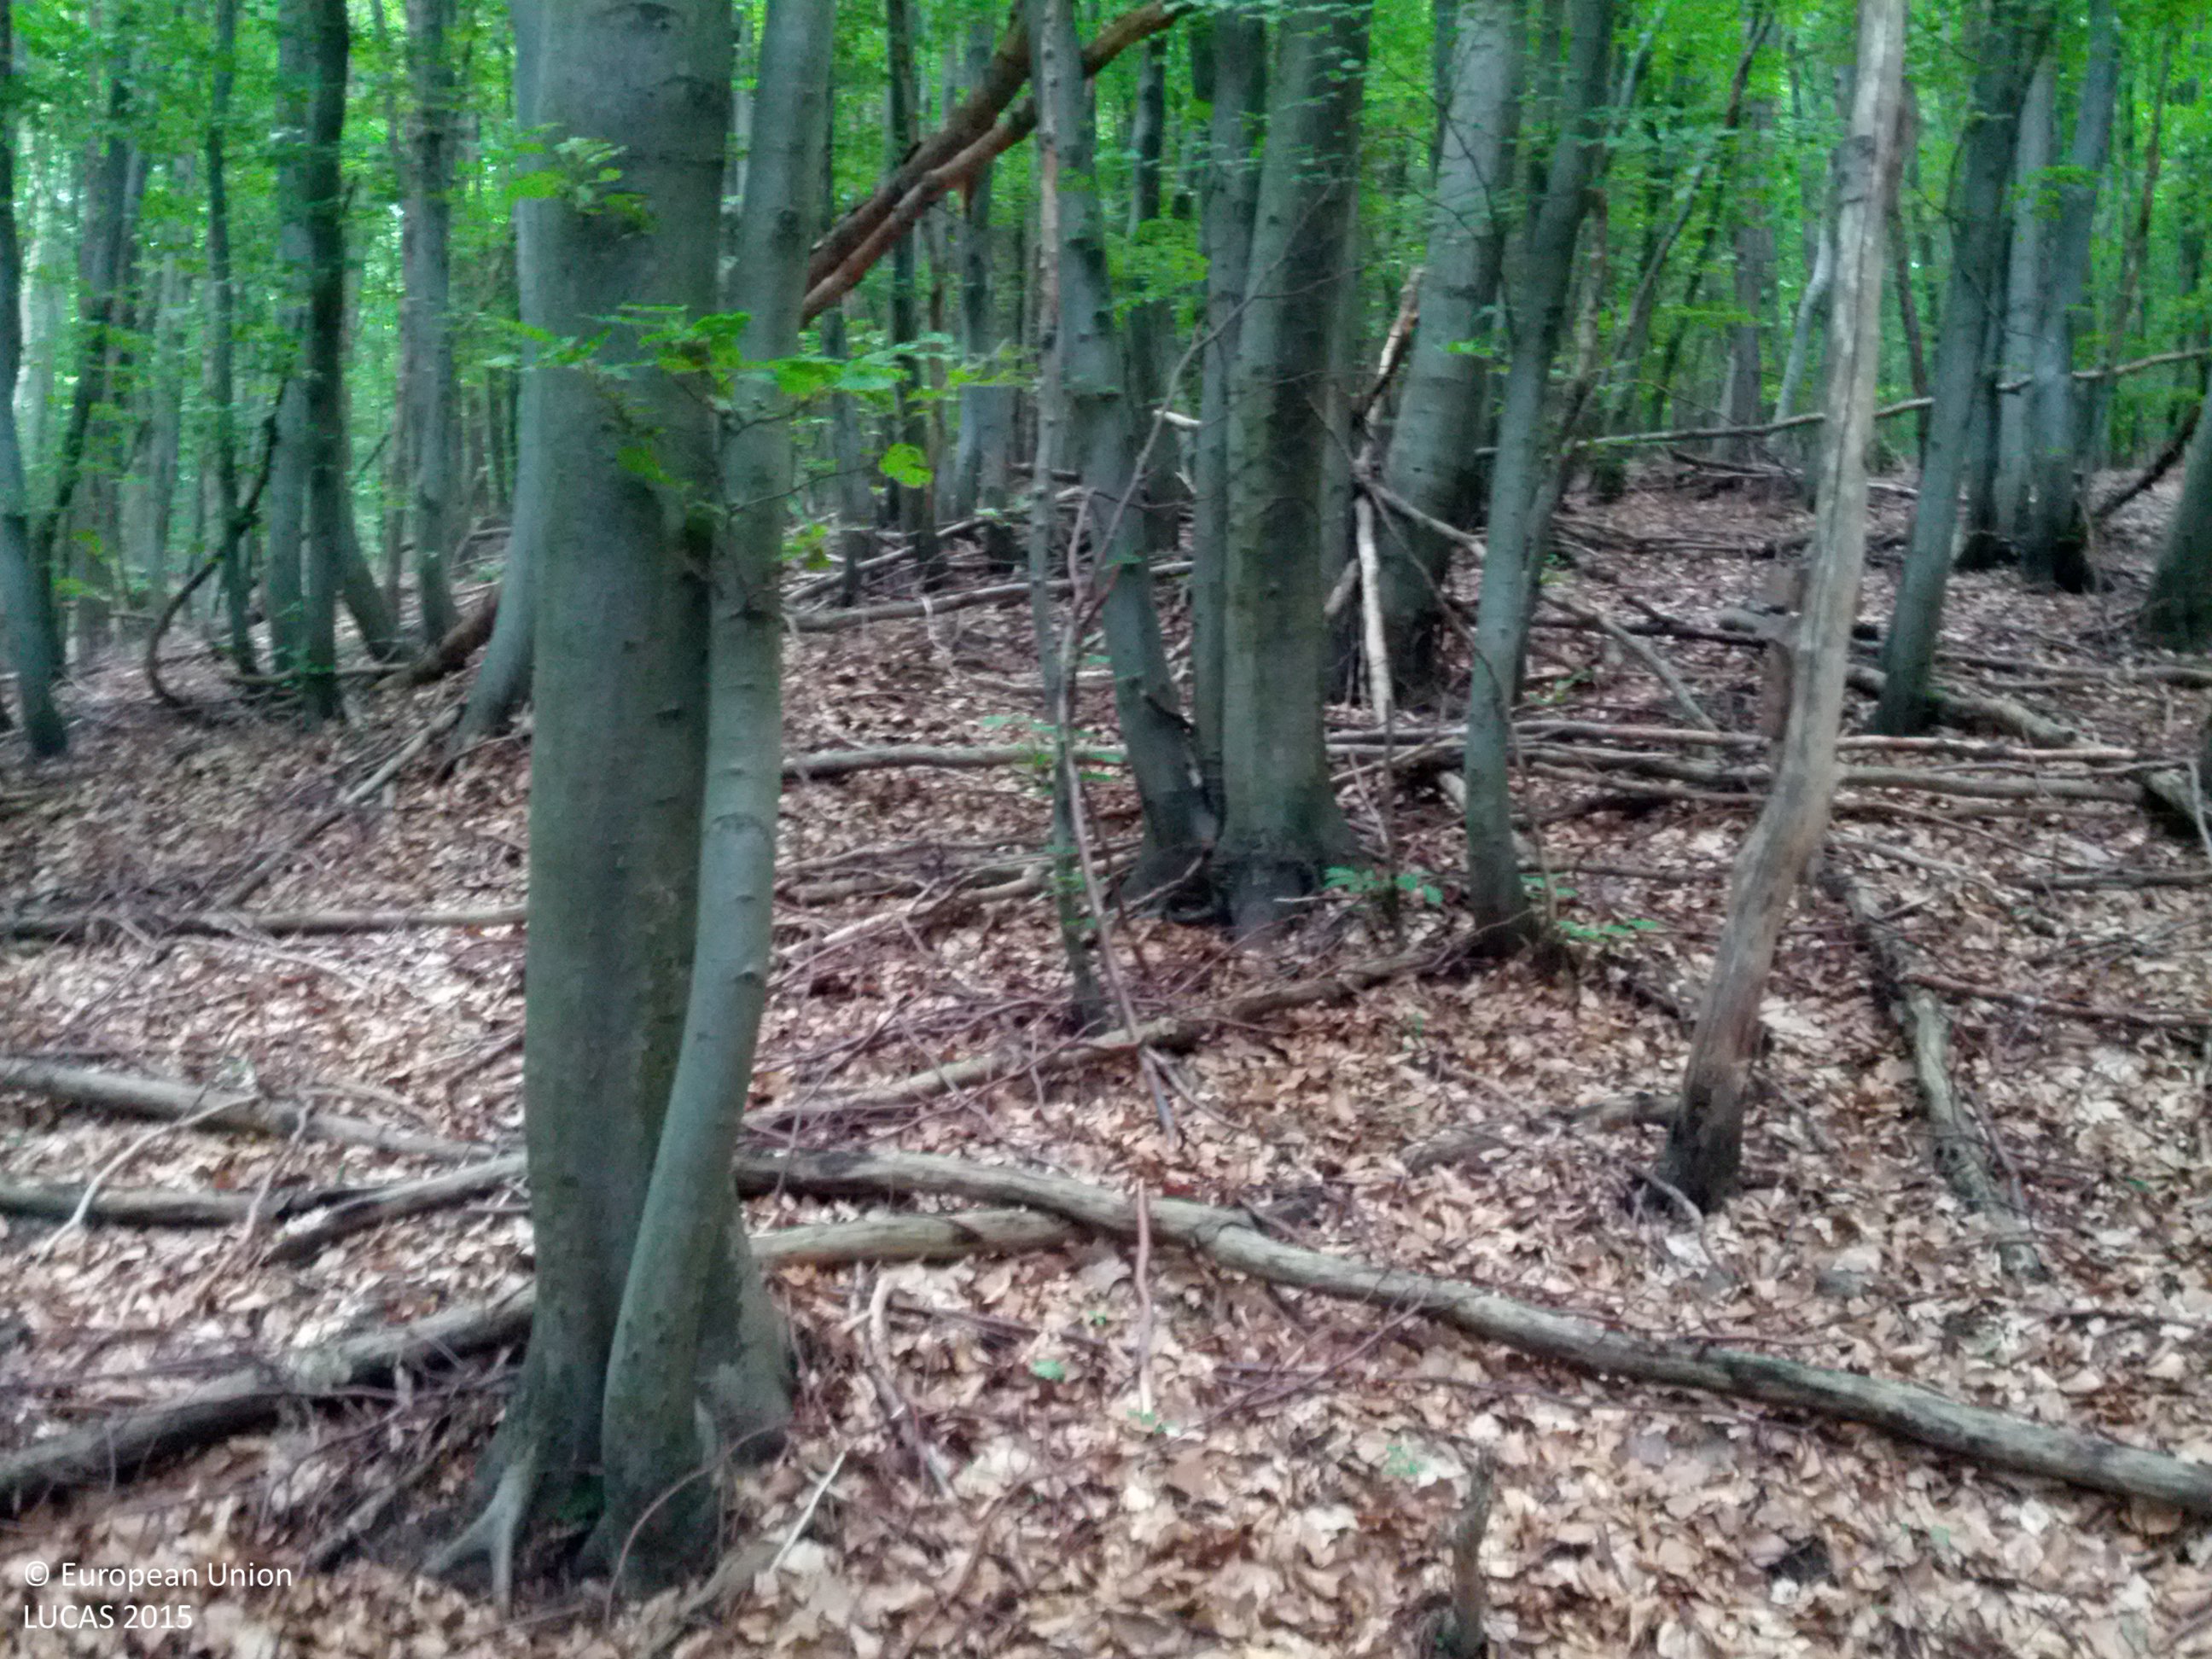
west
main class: Woodland
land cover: Broadleaved woodland
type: beech forest
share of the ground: > 75 %
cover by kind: broadleaved forest trees 95 %, herbaceous plants 5 %
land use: Forestry
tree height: > 5 m
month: May
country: AT
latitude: 48.2140
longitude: 16.1547
